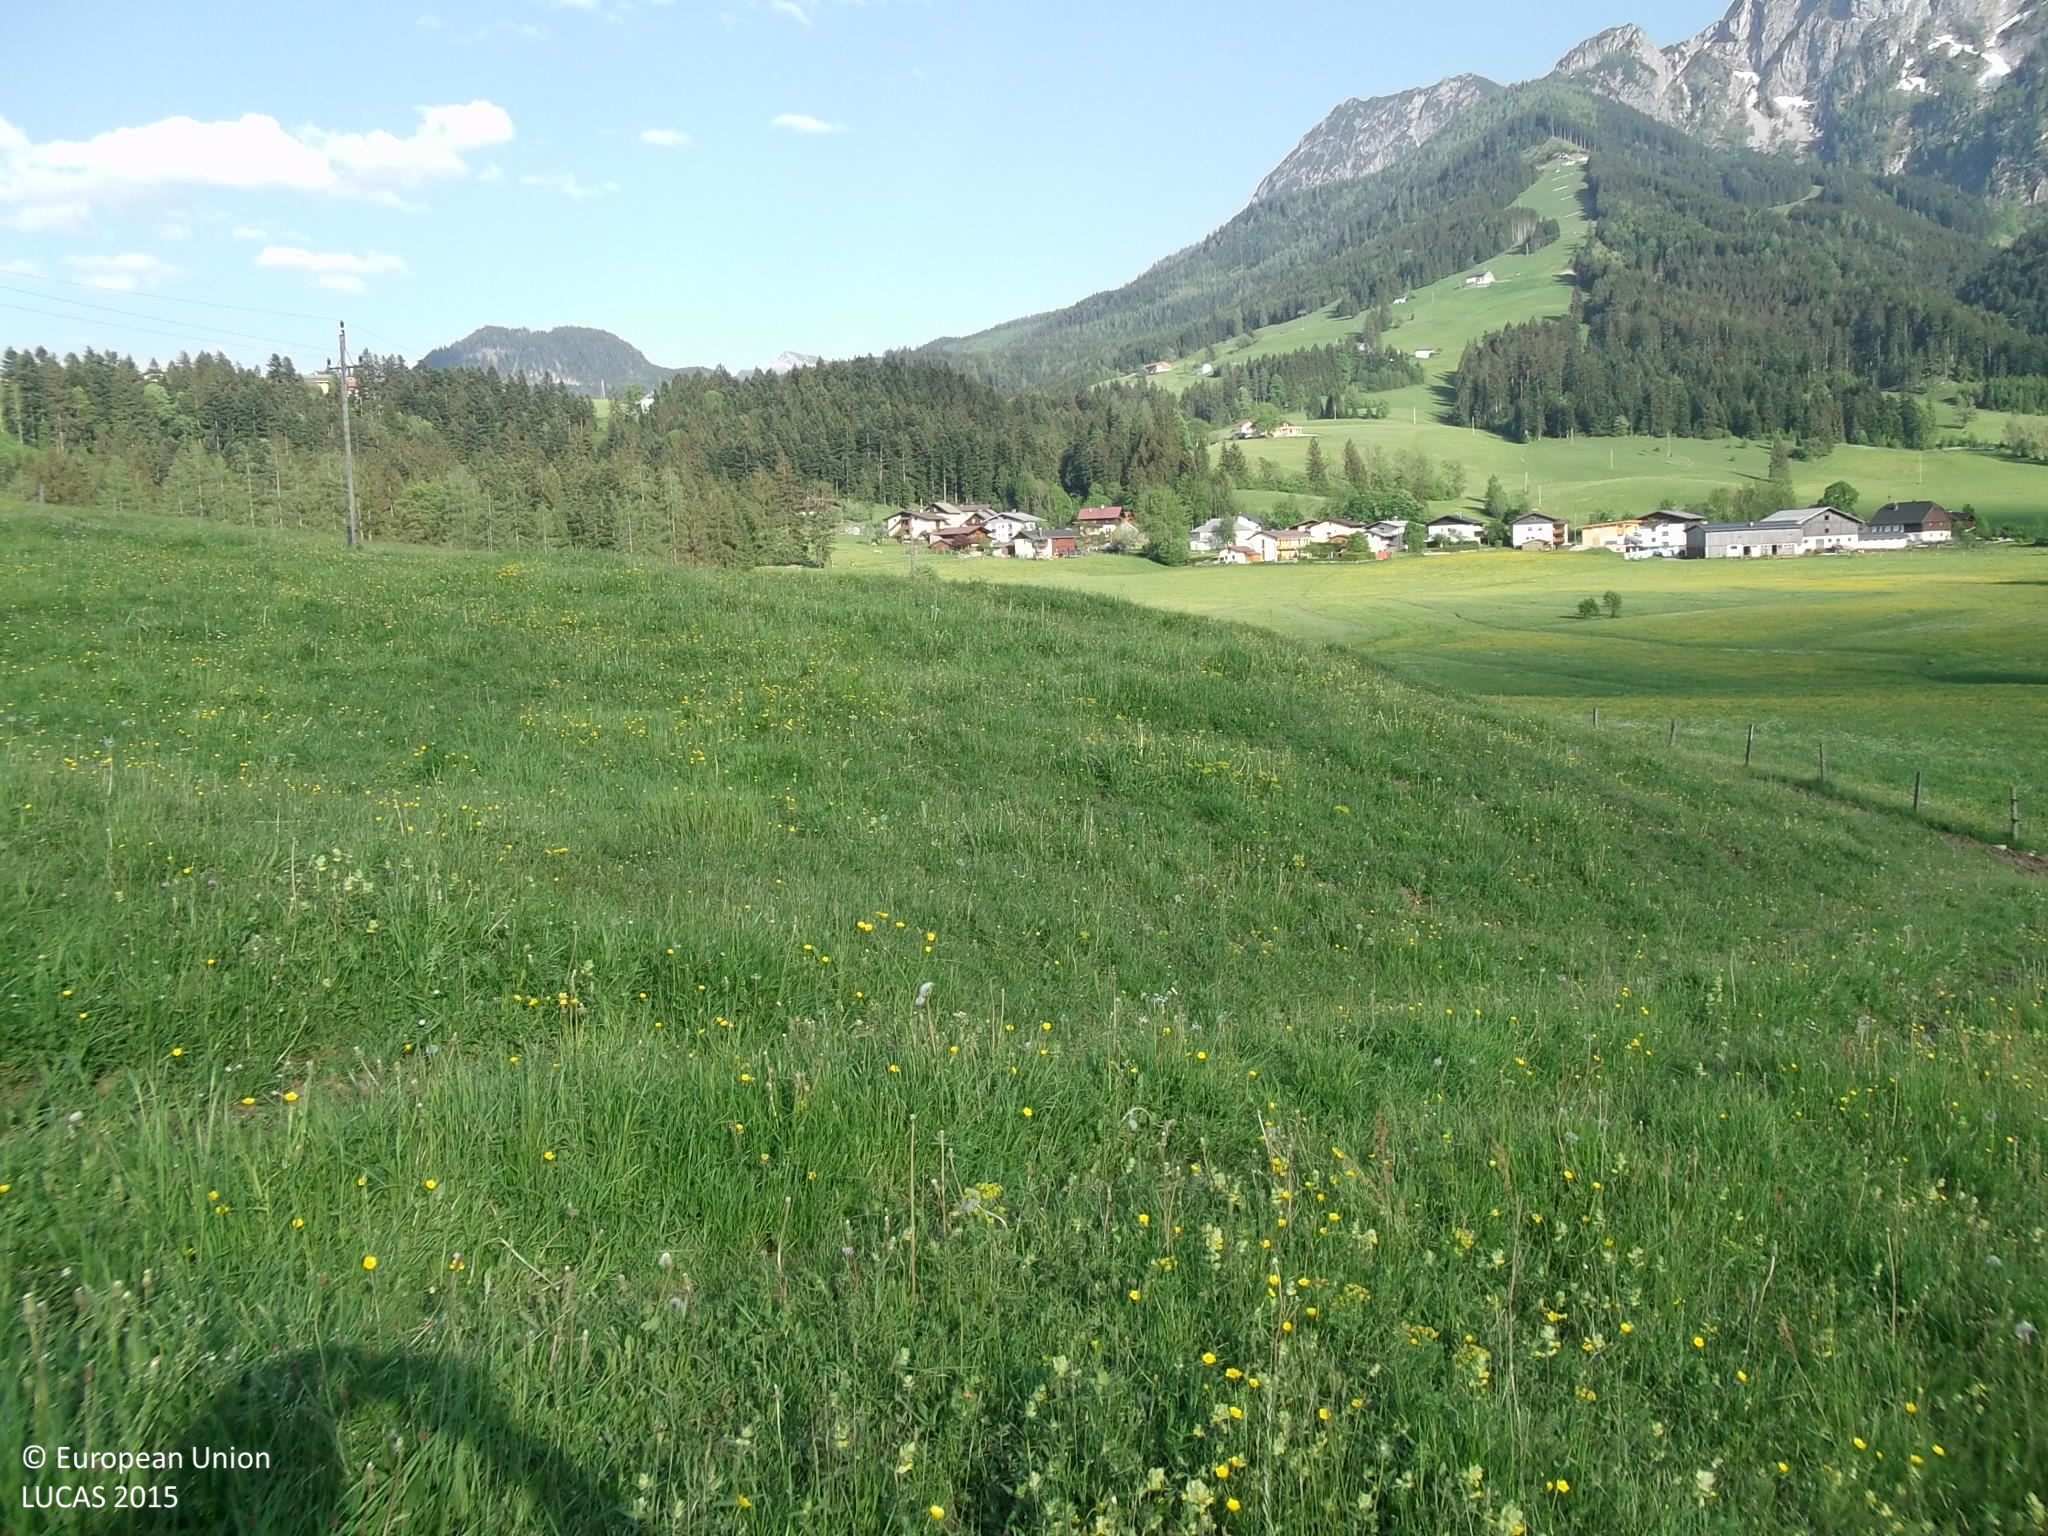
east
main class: Grassland
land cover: Grassland without tree/shrub cover
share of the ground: > 75 %
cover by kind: herbaceous plants 100 %
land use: Agriculture (excluding fallow land and kitchen gardens)
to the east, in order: Grassland without tree/shrub cover; Tracks; Grassland without tree/shrub cover; Electric lines; Grassland without tree/shrub cover; Fences; Grassland without tree/shrub cover; Single bushes/trees; Rivers and streams; Grassland without tree/shrub cover
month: May
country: AT
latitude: 47.5607
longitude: 13.3343
